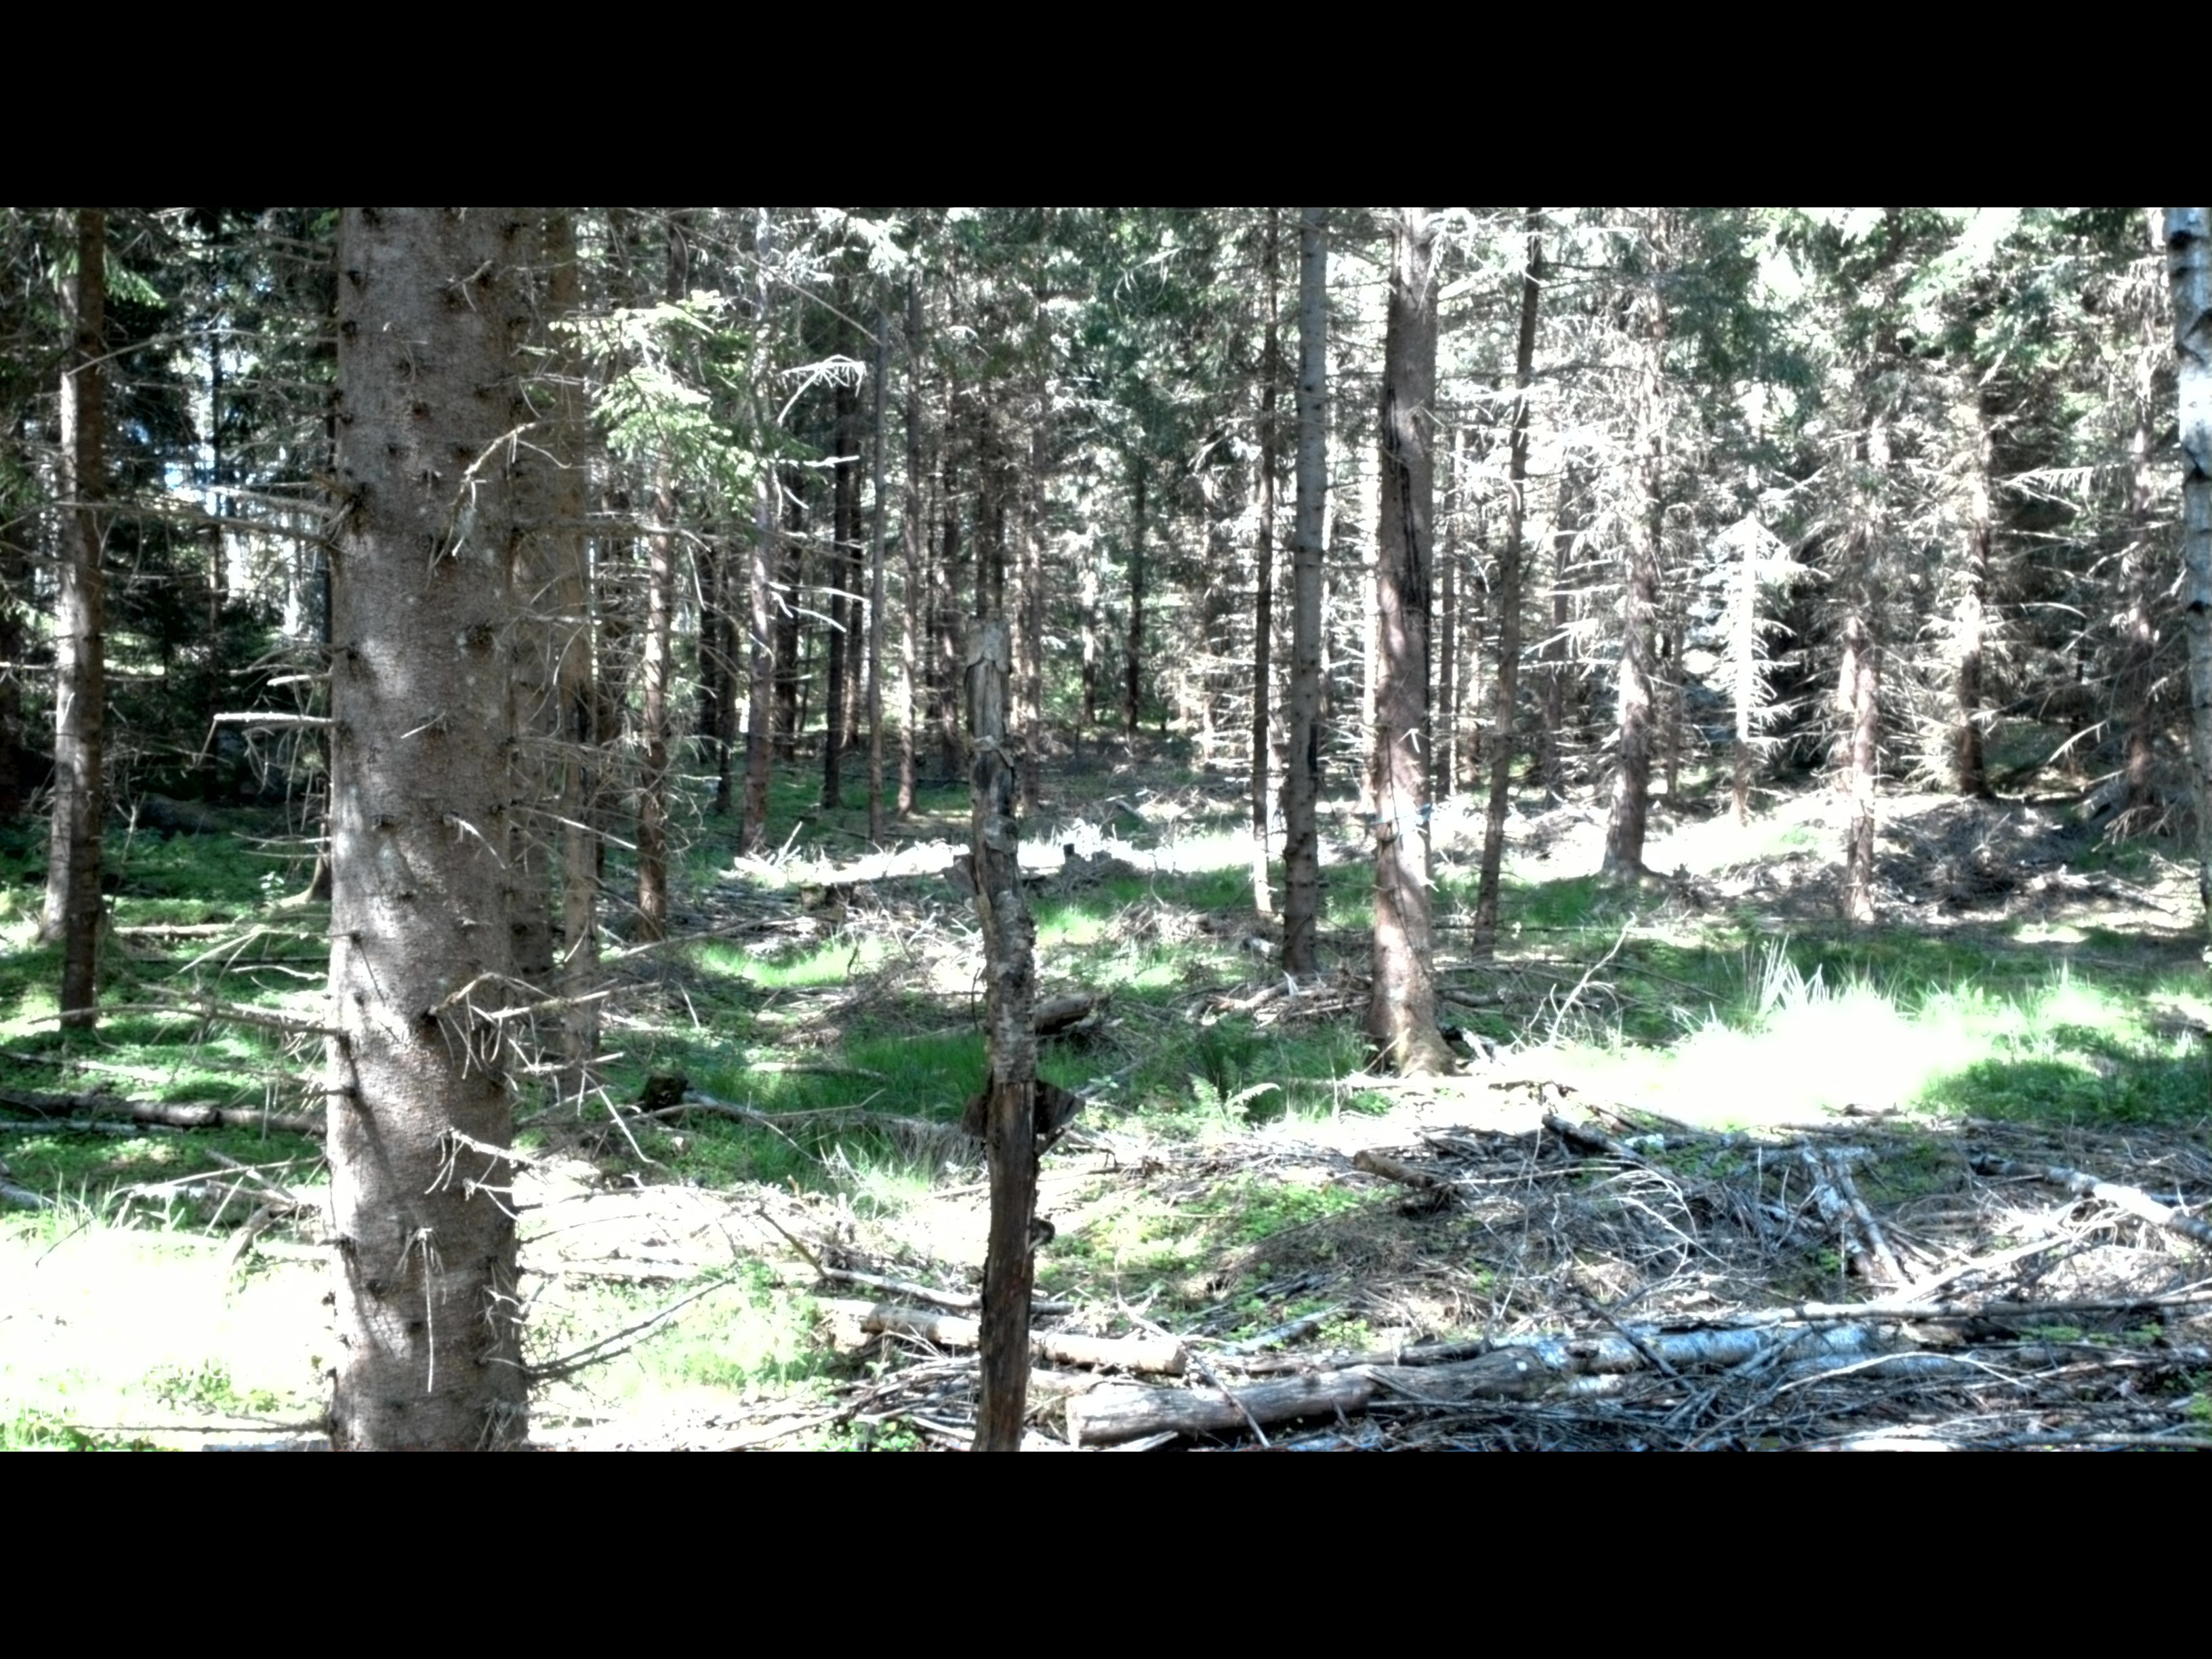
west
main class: Woodland
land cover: Spruce dominated coniferous woodland
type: boreal forest
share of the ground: 50 - 75 %
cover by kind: coniferous forest trees 55 %, herbaceous plants 25 %, broadleaved forest trees 10 %, unconsolidated bare surface 5 %
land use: Forestry
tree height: > 5 m
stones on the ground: < 10 %
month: June
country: SE
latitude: 57.7518
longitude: 16.1980
